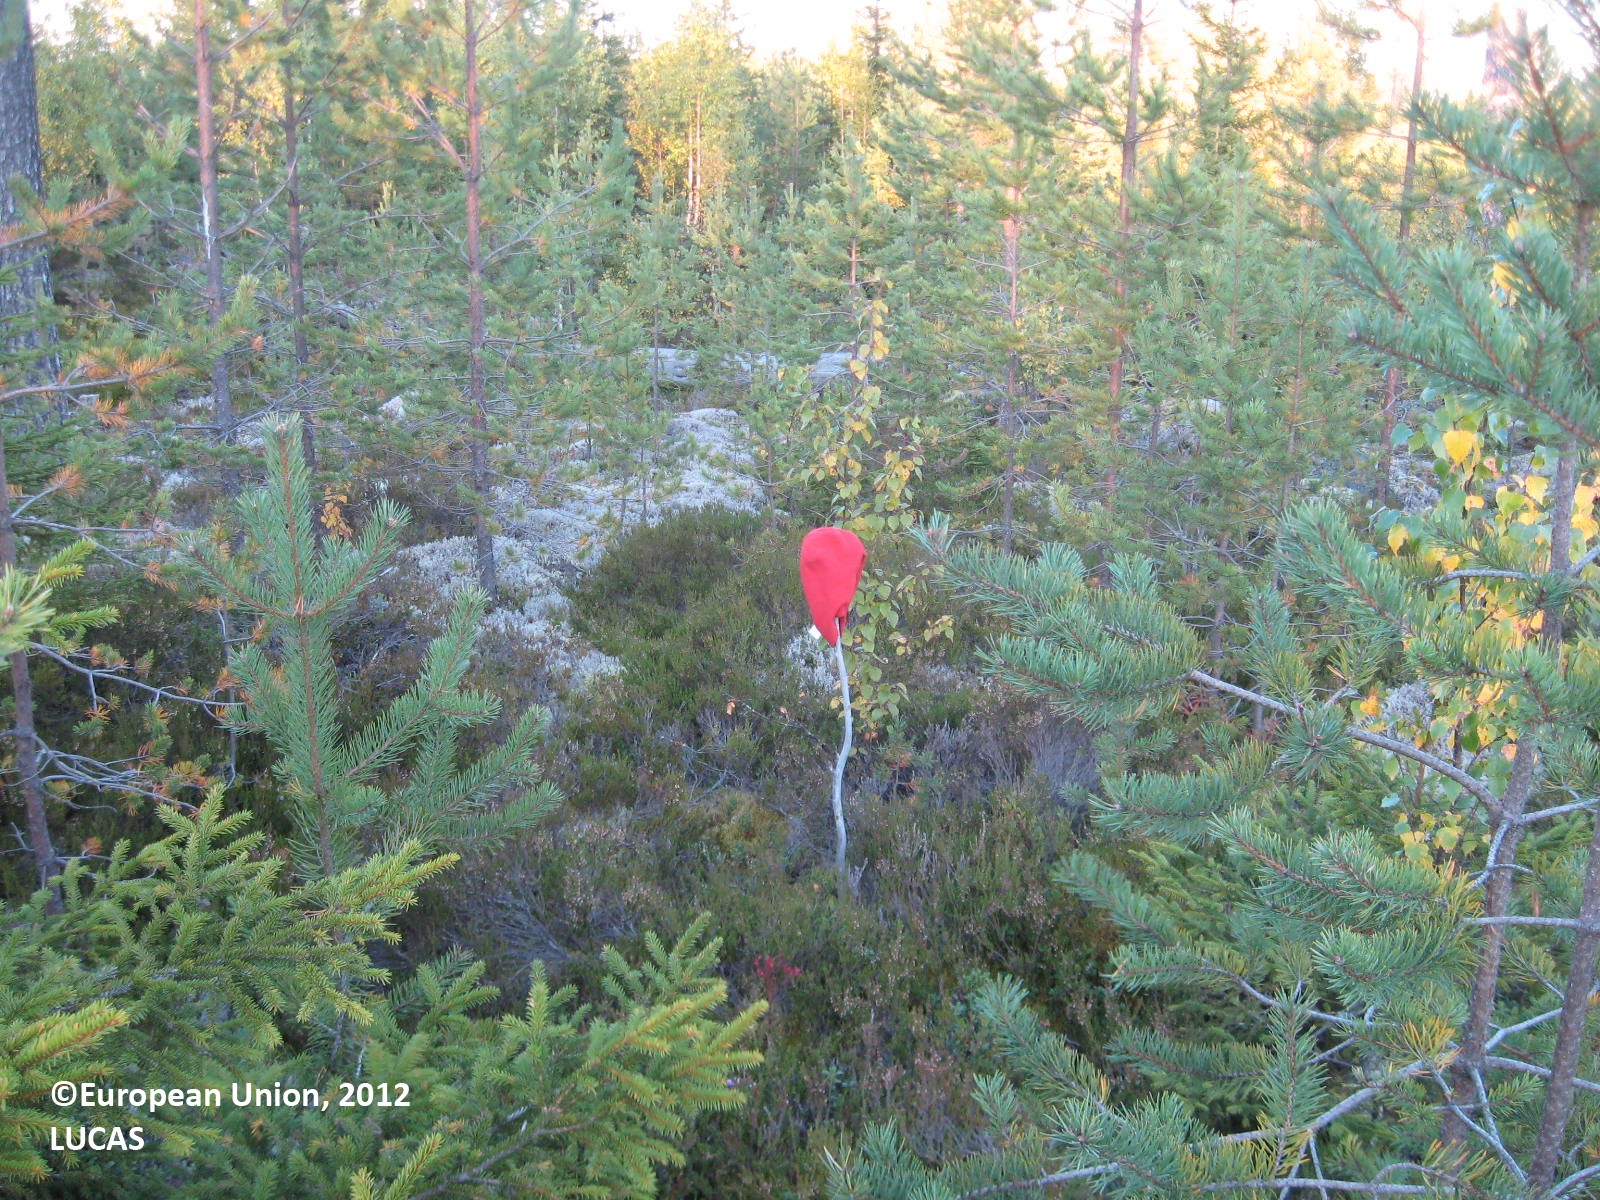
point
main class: Woodland
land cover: Pine dominated coniferous woodland
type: boreal forest
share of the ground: 50 - 75 %
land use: Forestry
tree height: < 5 m
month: August
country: FI
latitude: 63.8445
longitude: 29.7737
